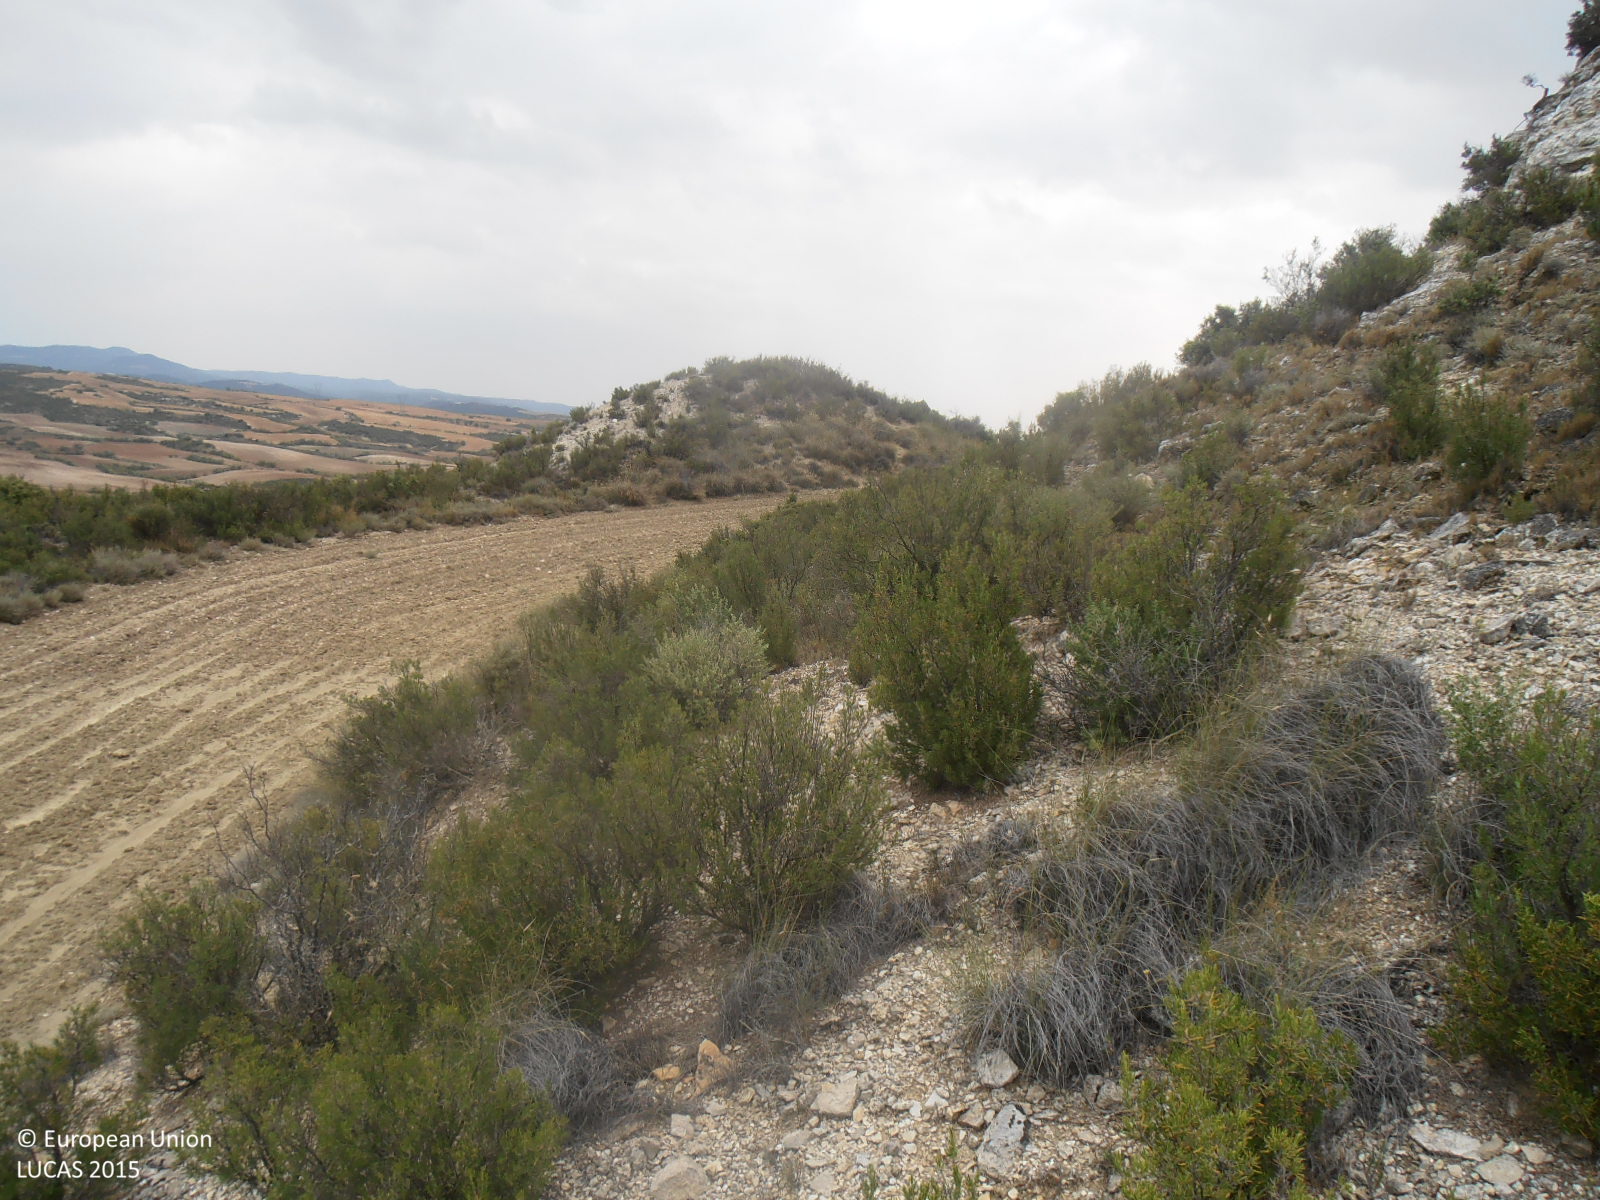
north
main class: Shrubland
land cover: Shrubland without tree cover
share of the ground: 50 - 75 %
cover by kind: shrubs 55 %, consolidated bare surface 45 %
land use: Semi-natural and natural areas not in use
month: June
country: ES
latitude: 41.9069
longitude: -0.8373
